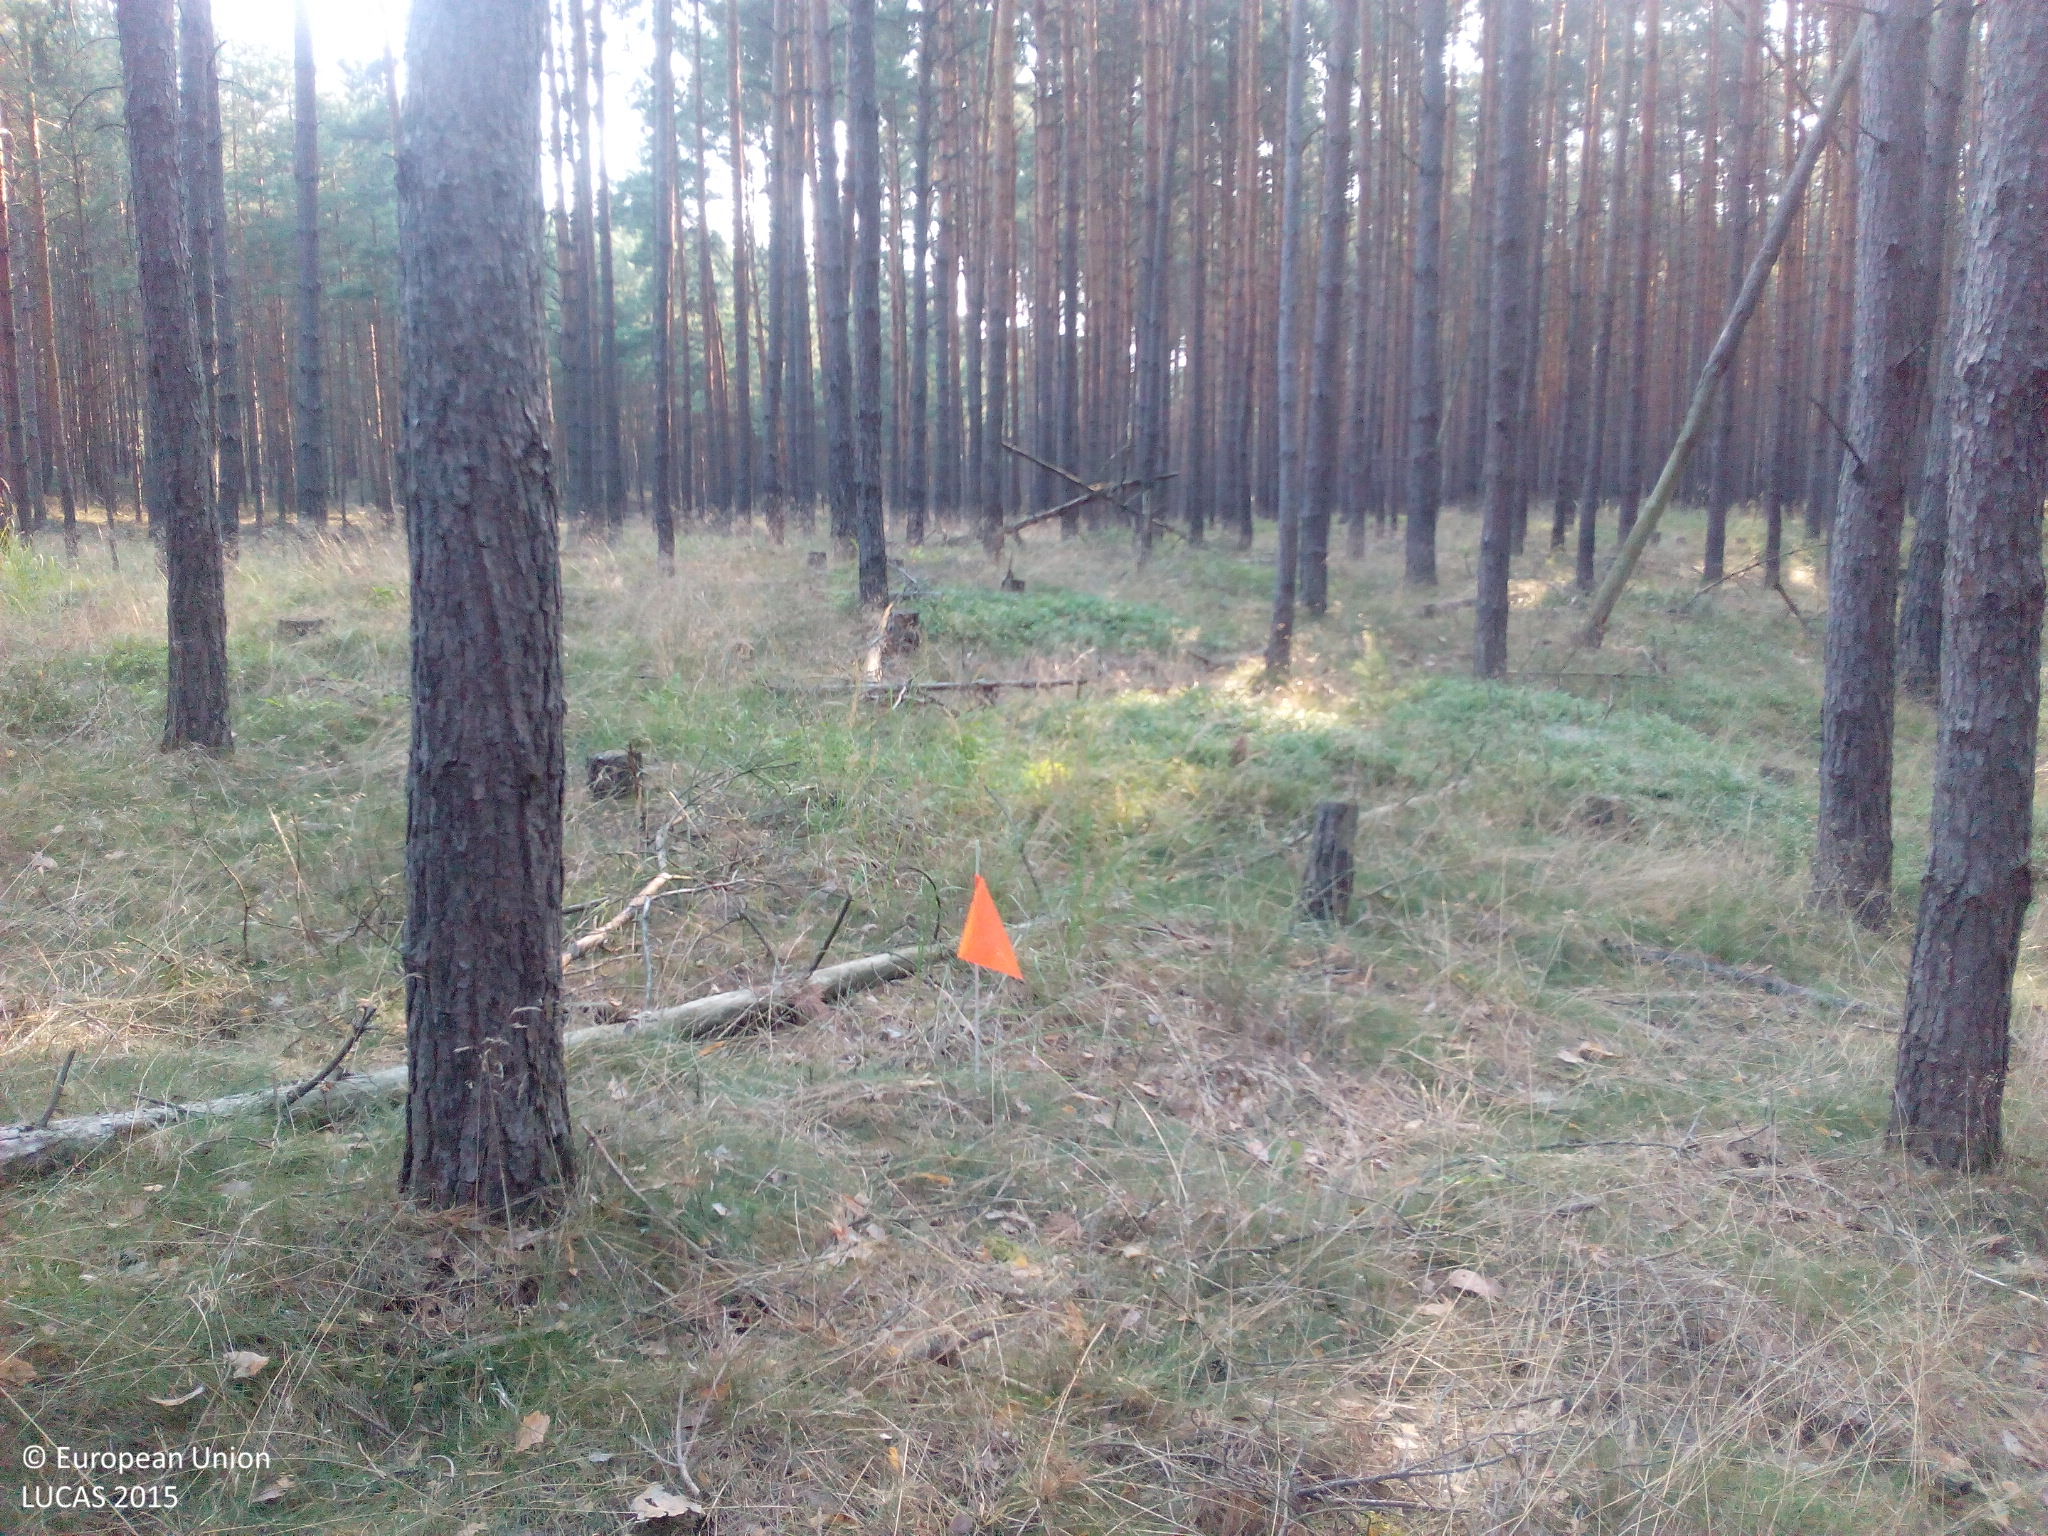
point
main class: Woodland
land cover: Pine dominated coniferous woodland
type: hemiboreal forest and nemoral coniferous forest and mixed broadleaved-coniferous forest
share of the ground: > 75 %
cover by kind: coniferous forest trees 95 %, herbaceous plants 5 %
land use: Forestry
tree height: > 5 m
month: August
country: DE
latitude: 51.6795
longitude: 13.4569
